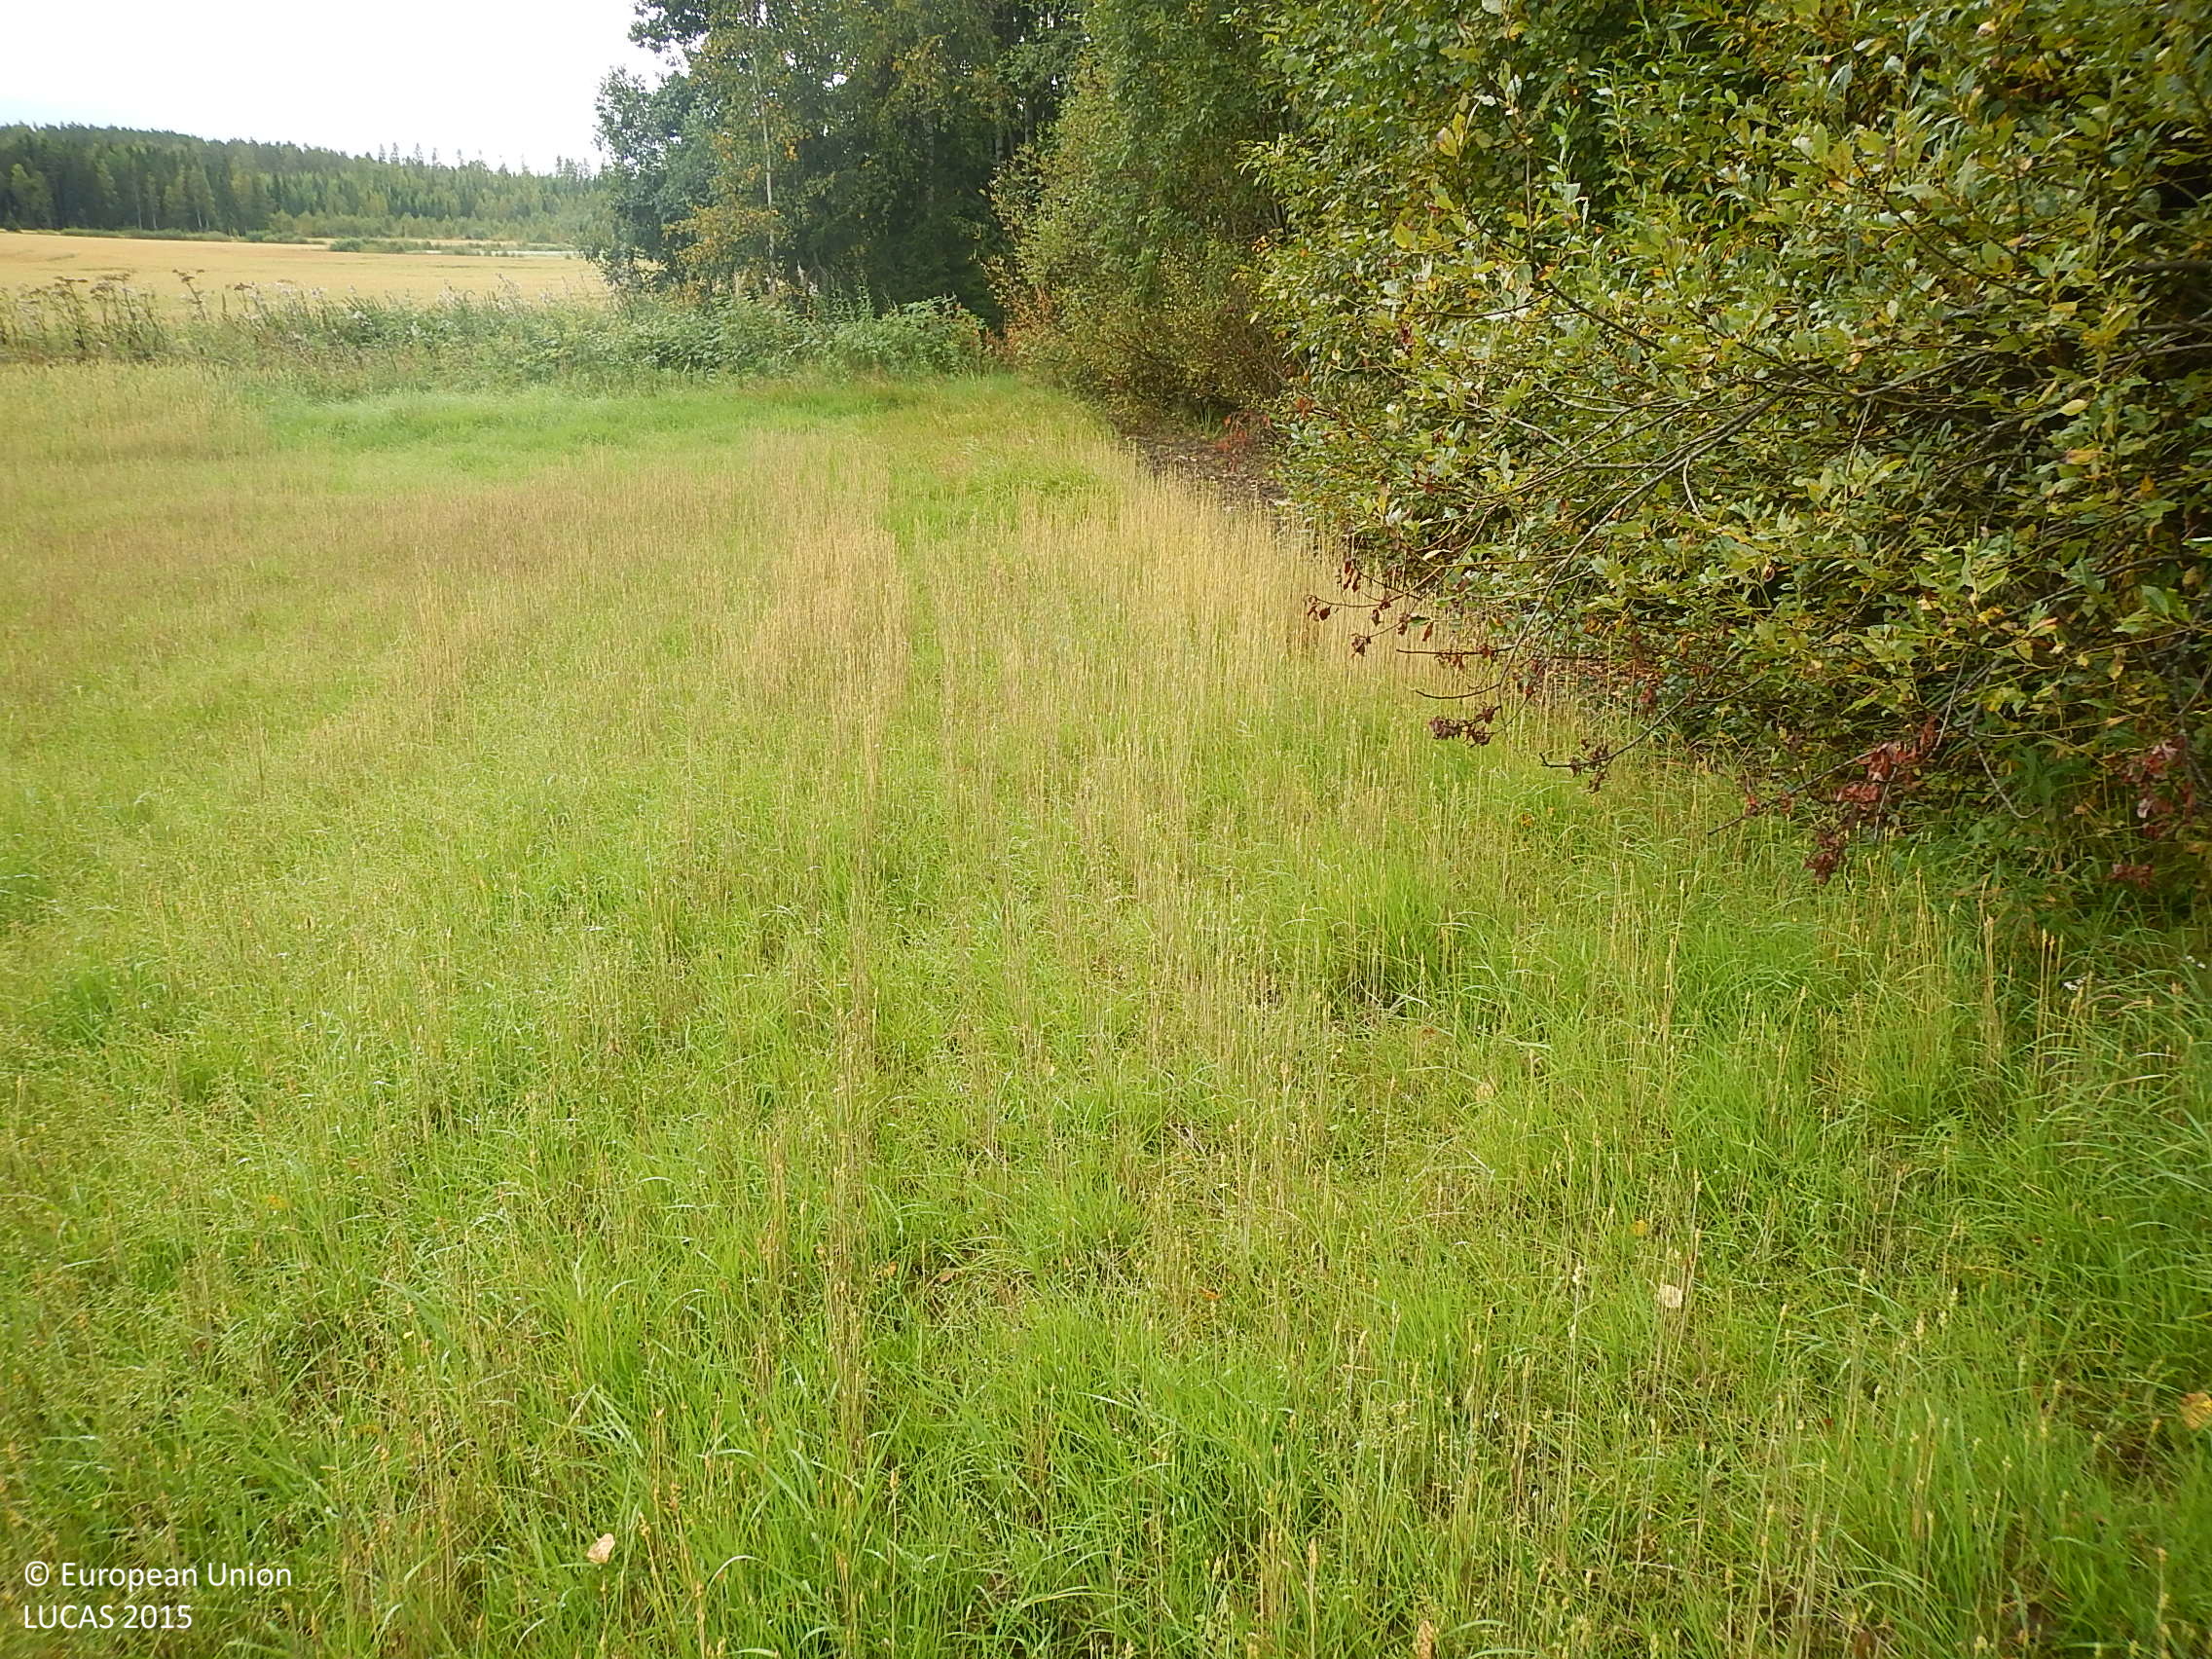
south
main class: Cropland
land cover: Common wheat
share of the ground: 25 - 50 %
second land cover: Spontaneously vegetated surfaces
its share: 50 - 75 %
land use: Agriculture (excluding fallow land and kitchen gardens)
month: September
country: FI
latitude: 61.4860
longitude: 22.7044
